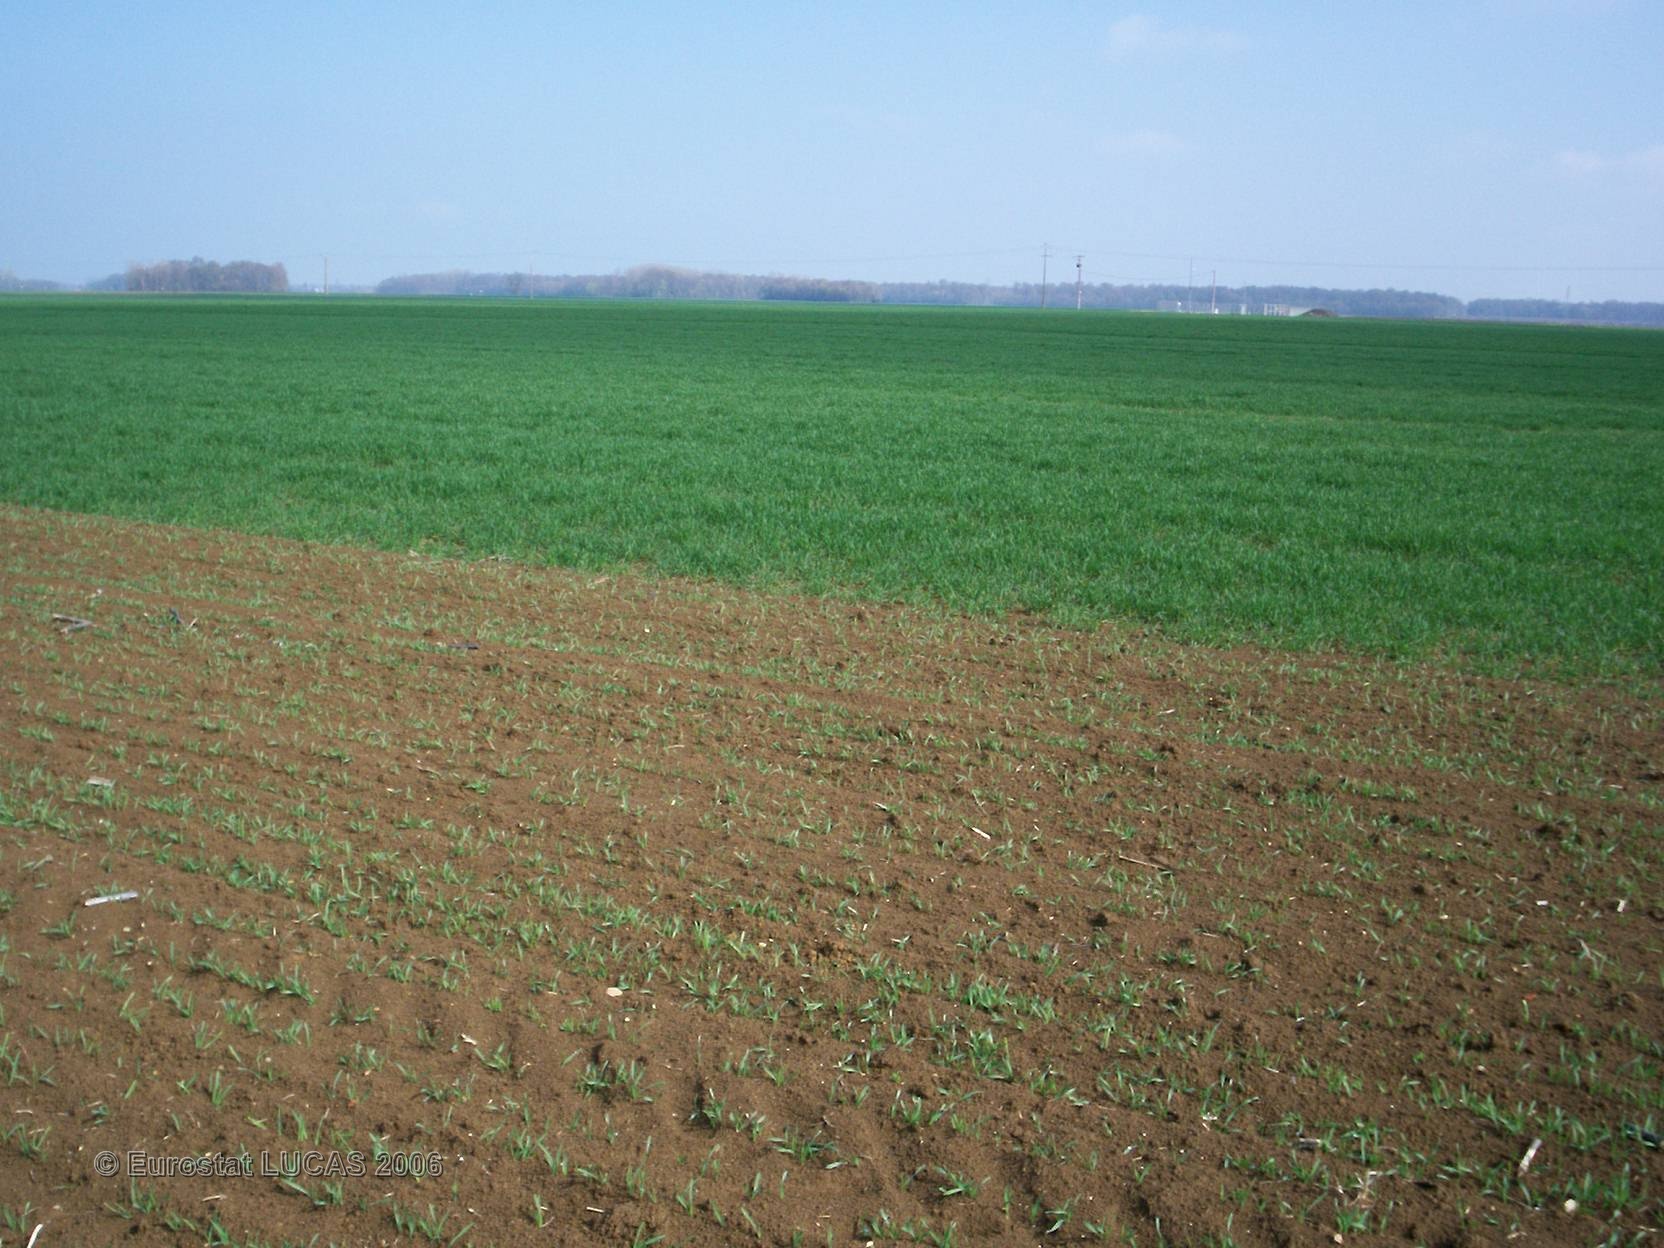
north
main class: Cropland
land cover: Rye
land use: Agriculture (excluding fallow land and kitchen gardens)
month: April
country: FR
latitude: 47.0260
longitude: 5.3569
